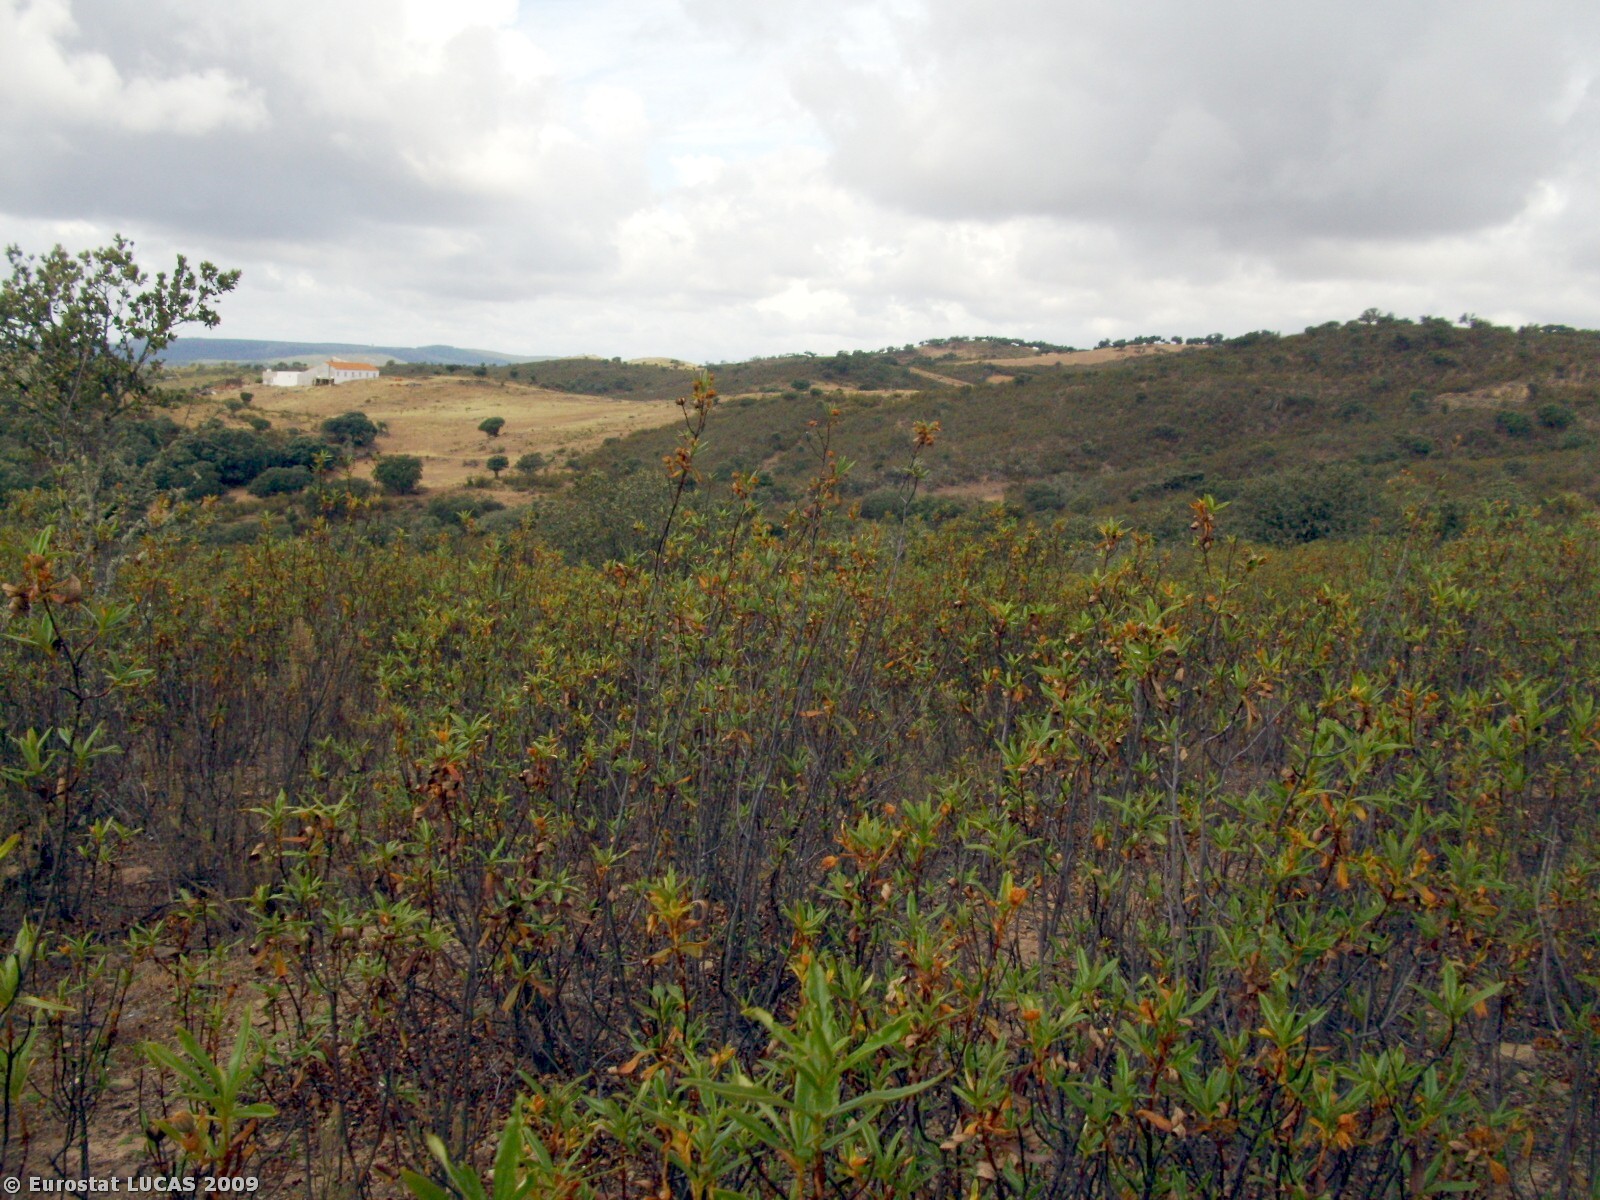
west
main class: Woodland
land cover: Broadleaved woodland
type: broadleaved evergreen forest
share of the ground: 10 - 25 %
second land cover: Shrubland with sparse tree cover
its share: 50 - 75 %
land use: Forestry
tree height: > 5 m
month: June
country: PT
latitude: 39.6736
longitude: -7.2153
